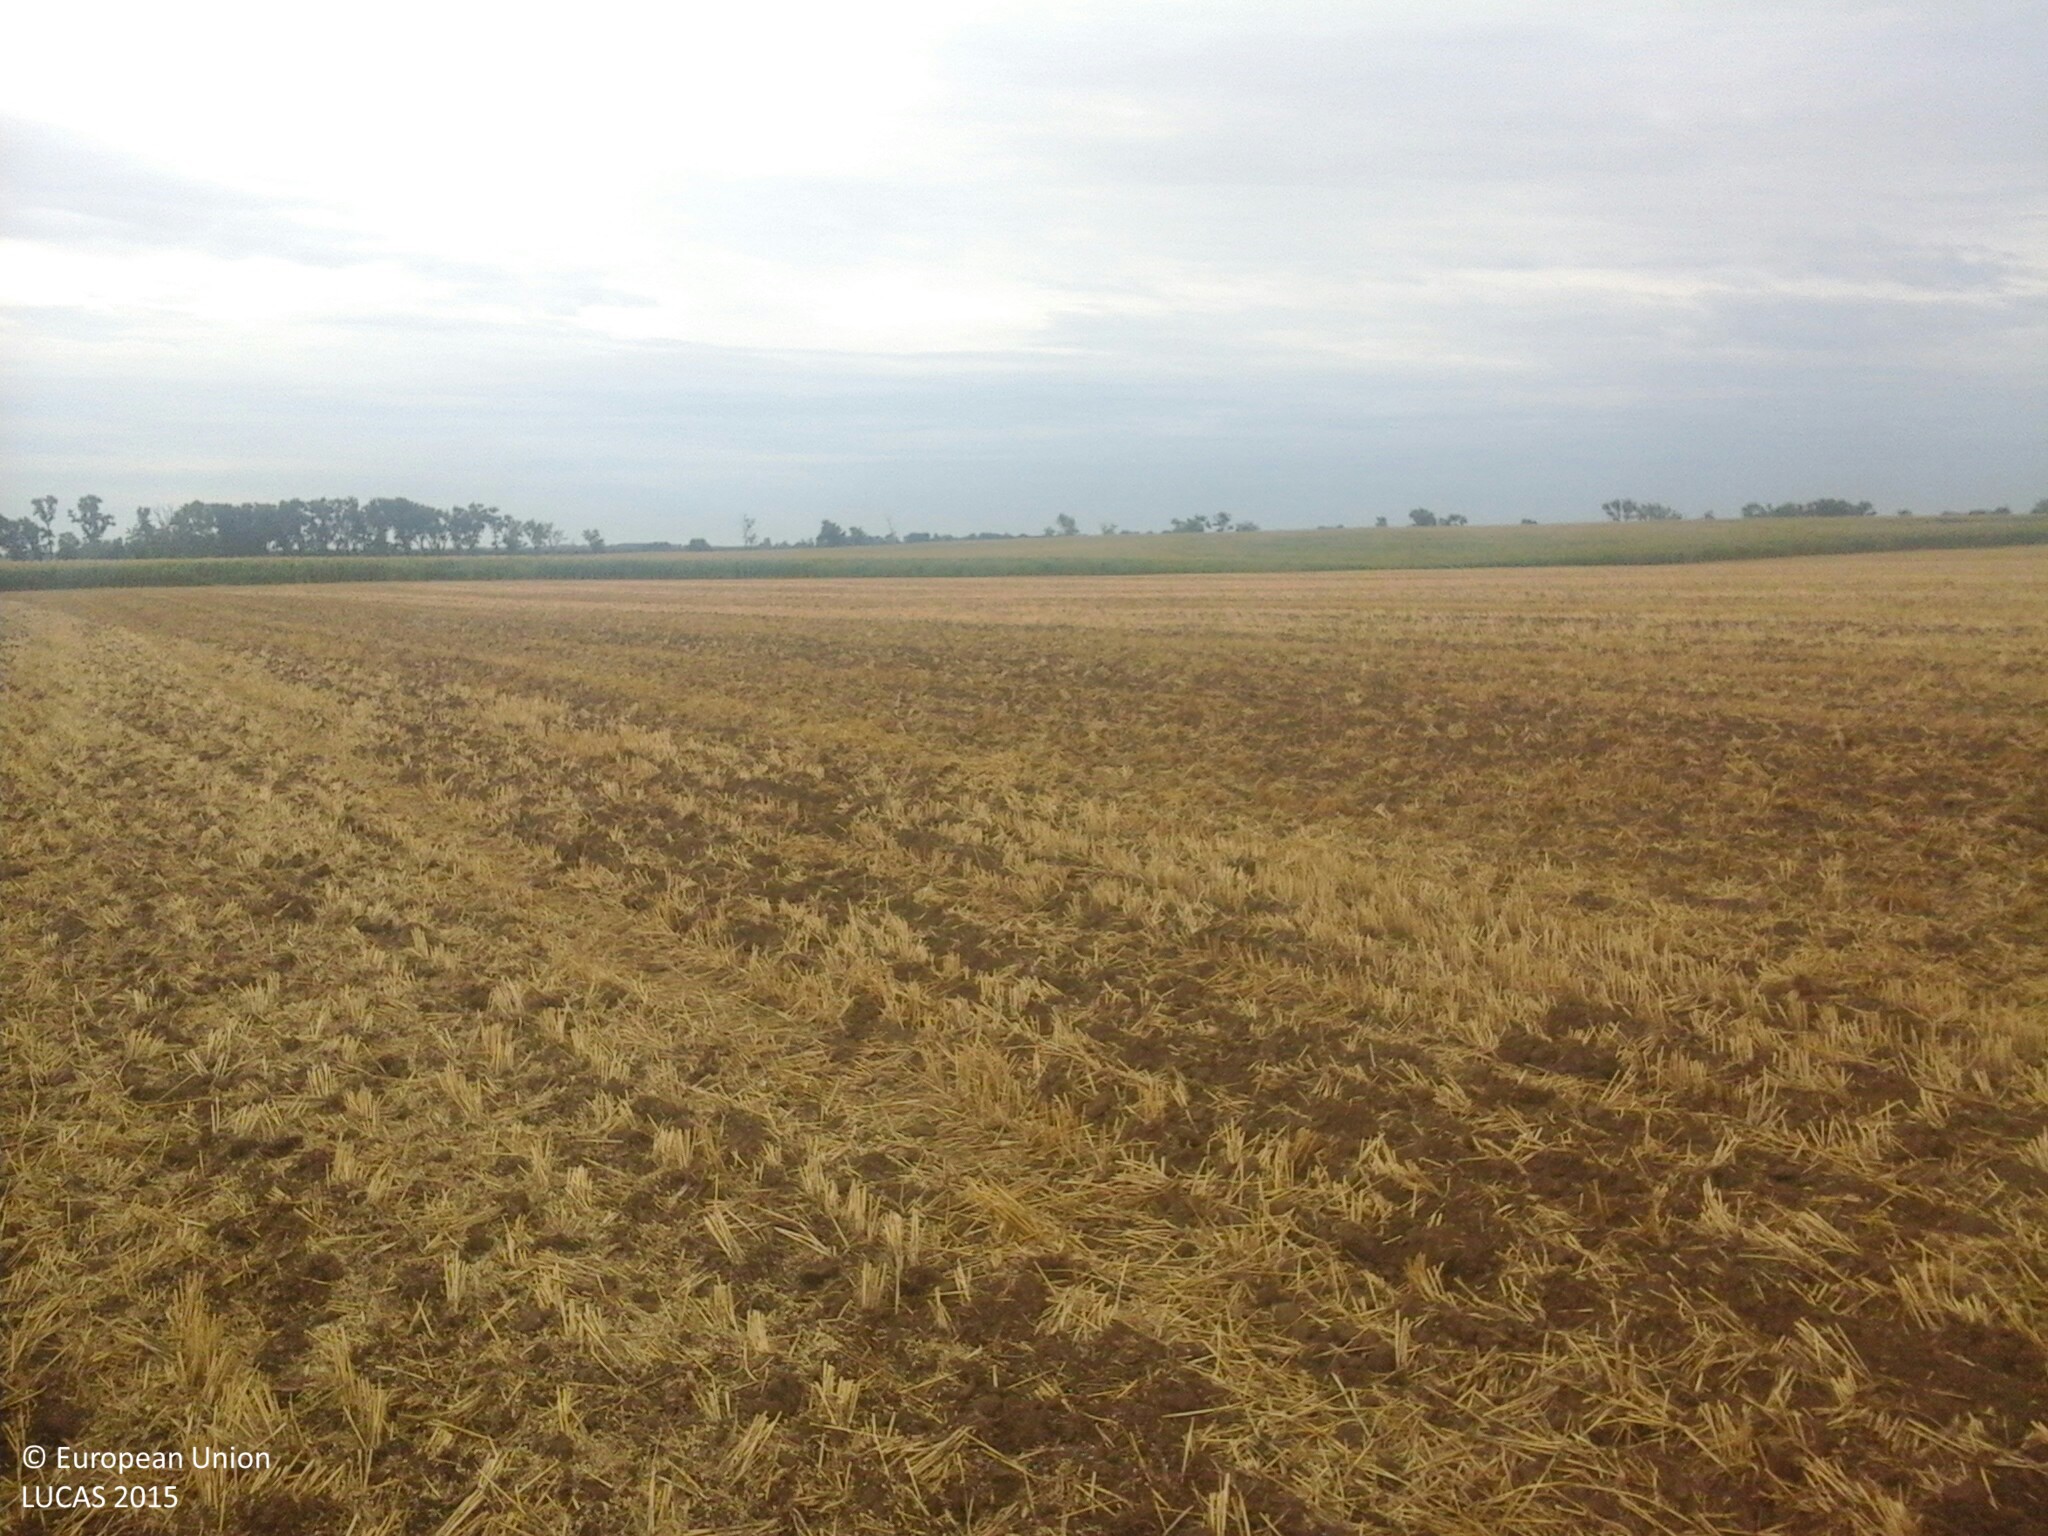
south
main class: Cropland
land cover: Oats
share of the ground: < 10 %
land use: Agriculture (excluding fallow land and kitchen gardens)
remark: Harvested field
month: July
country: HU
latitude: 47.0723
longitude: 18.3738
